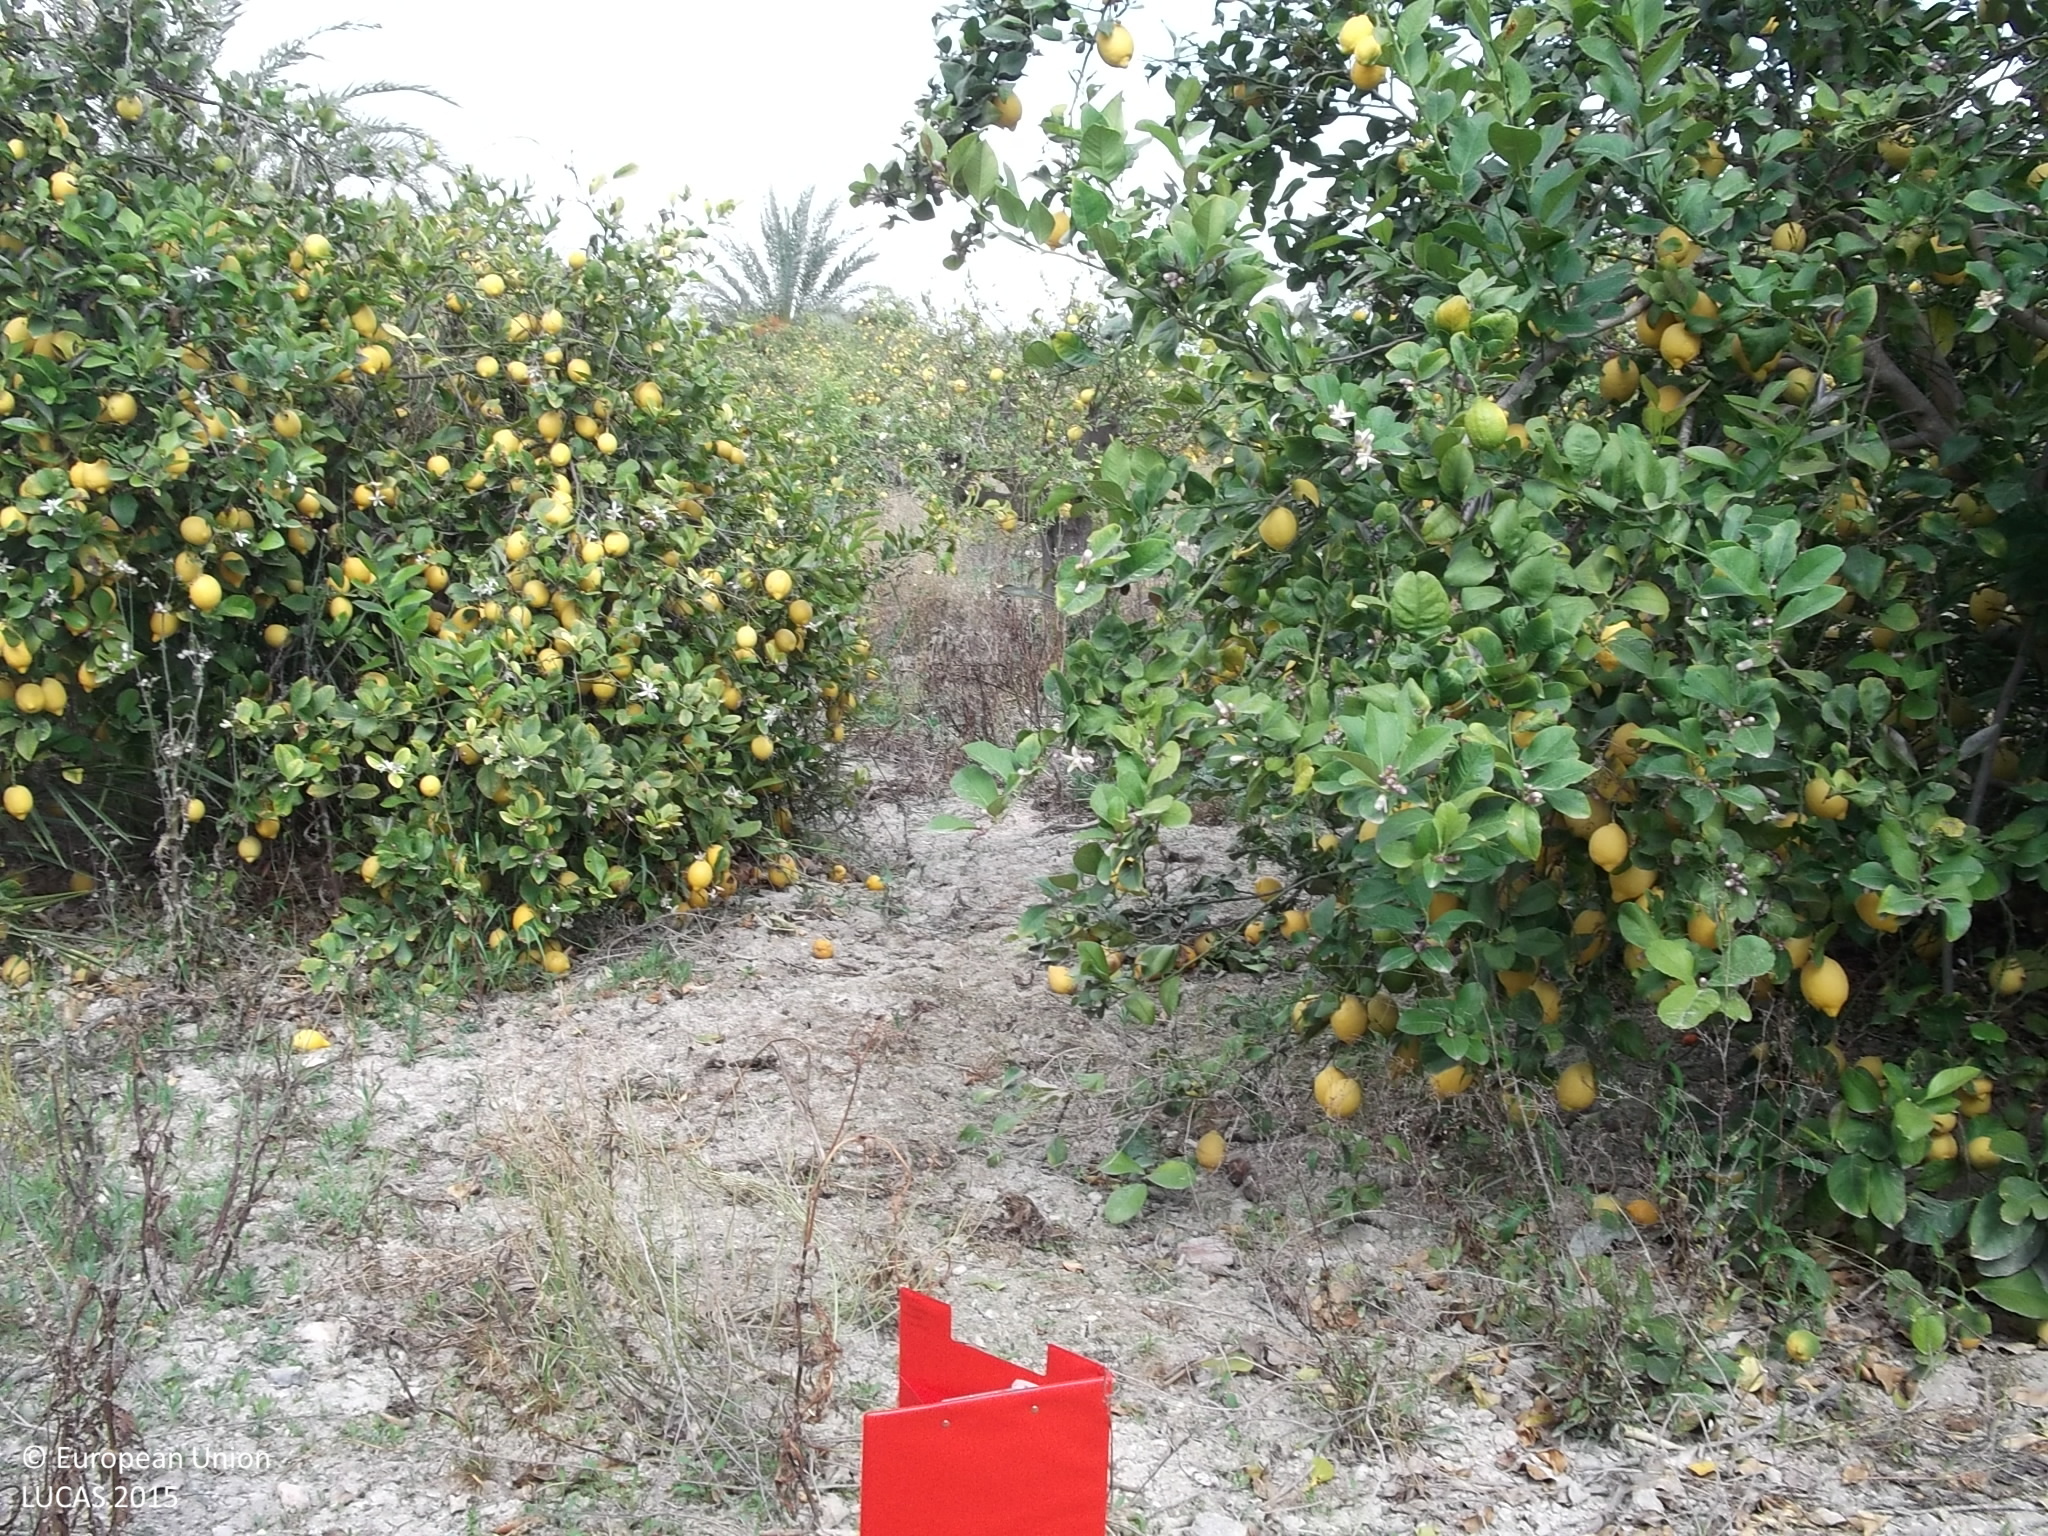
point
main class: Cropland
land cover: Other citrus fruit
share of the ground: 25 - 50 %
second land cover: Other bare soil
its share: > 75 %
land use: Agriculture (excluding fallow land and kitchen gardens)
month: April
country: ES
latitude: 38.1498
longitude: -0.9971
